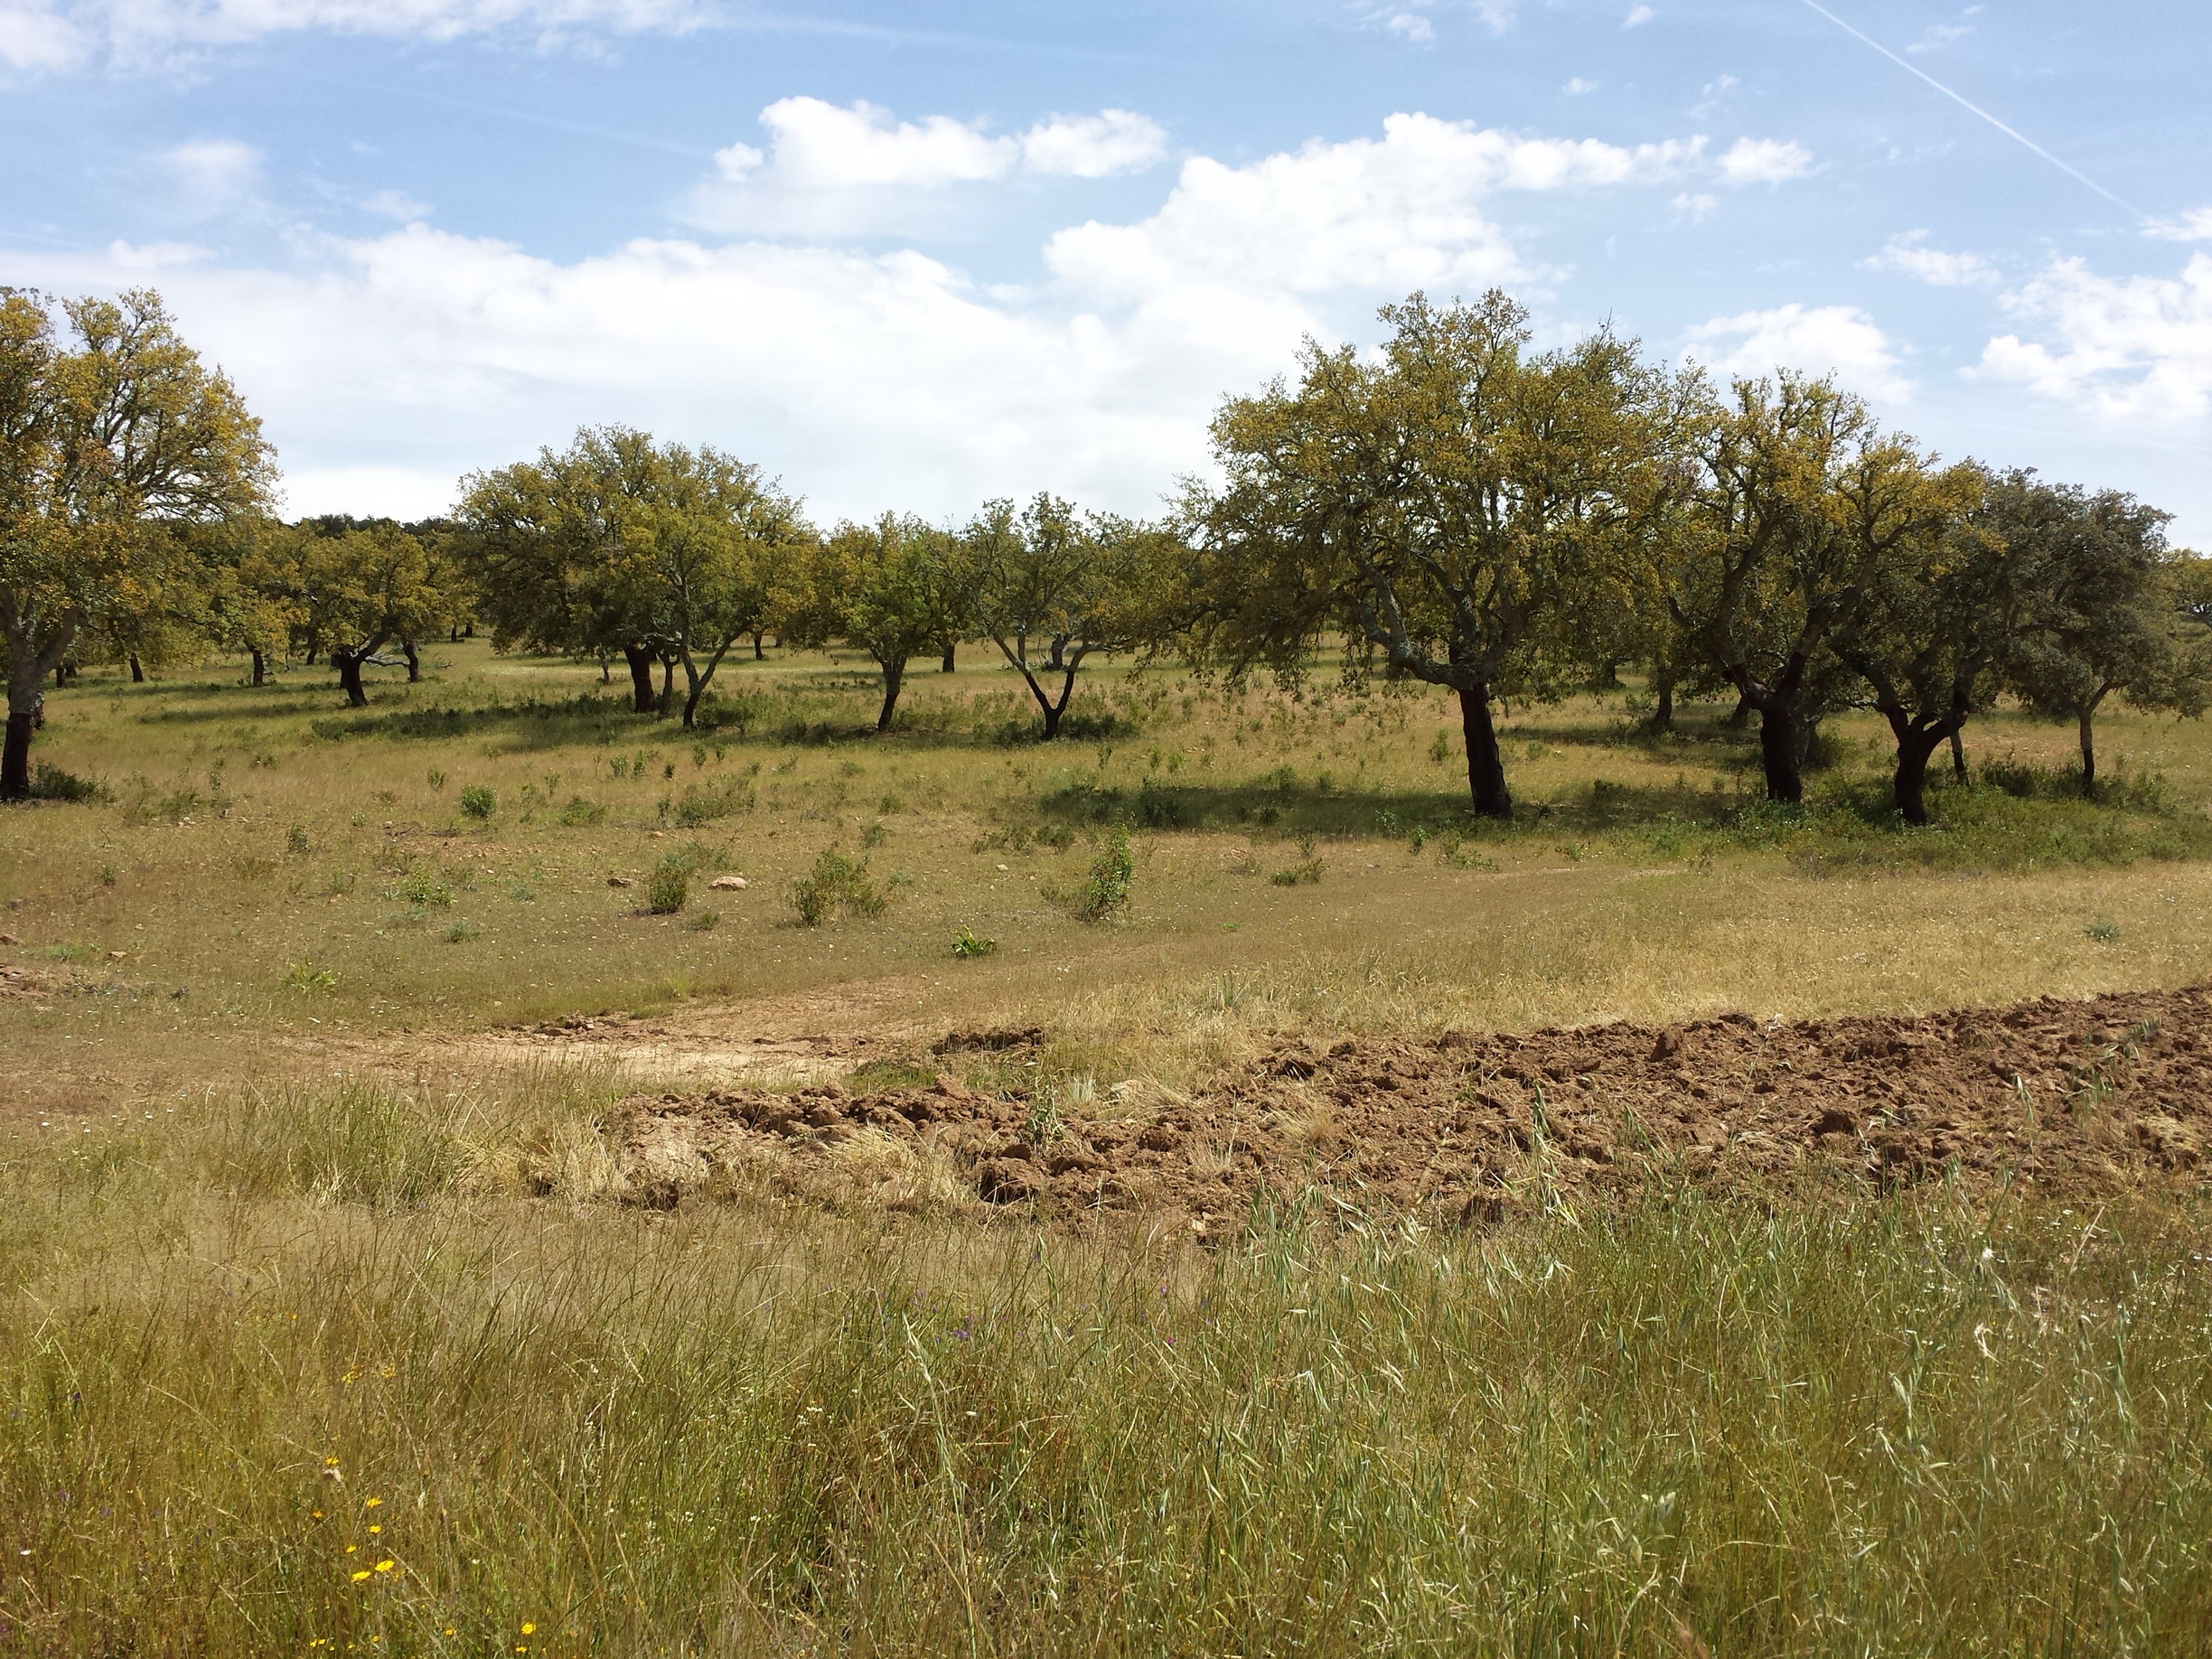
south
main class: Woodland
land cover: Broadleaved woodland
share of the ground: 25 - 50 %
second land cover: Grassland without tree/shrub cover
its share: > 75 %
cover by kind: herbaceous plants 75 %, broadleaved forest trees 25 %
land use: Forestry
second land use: Agriculture (excluding fallow land and kitchen gardens)
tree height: < 5 m
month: May
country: ES
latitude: 39.5504
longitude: -7.1820
